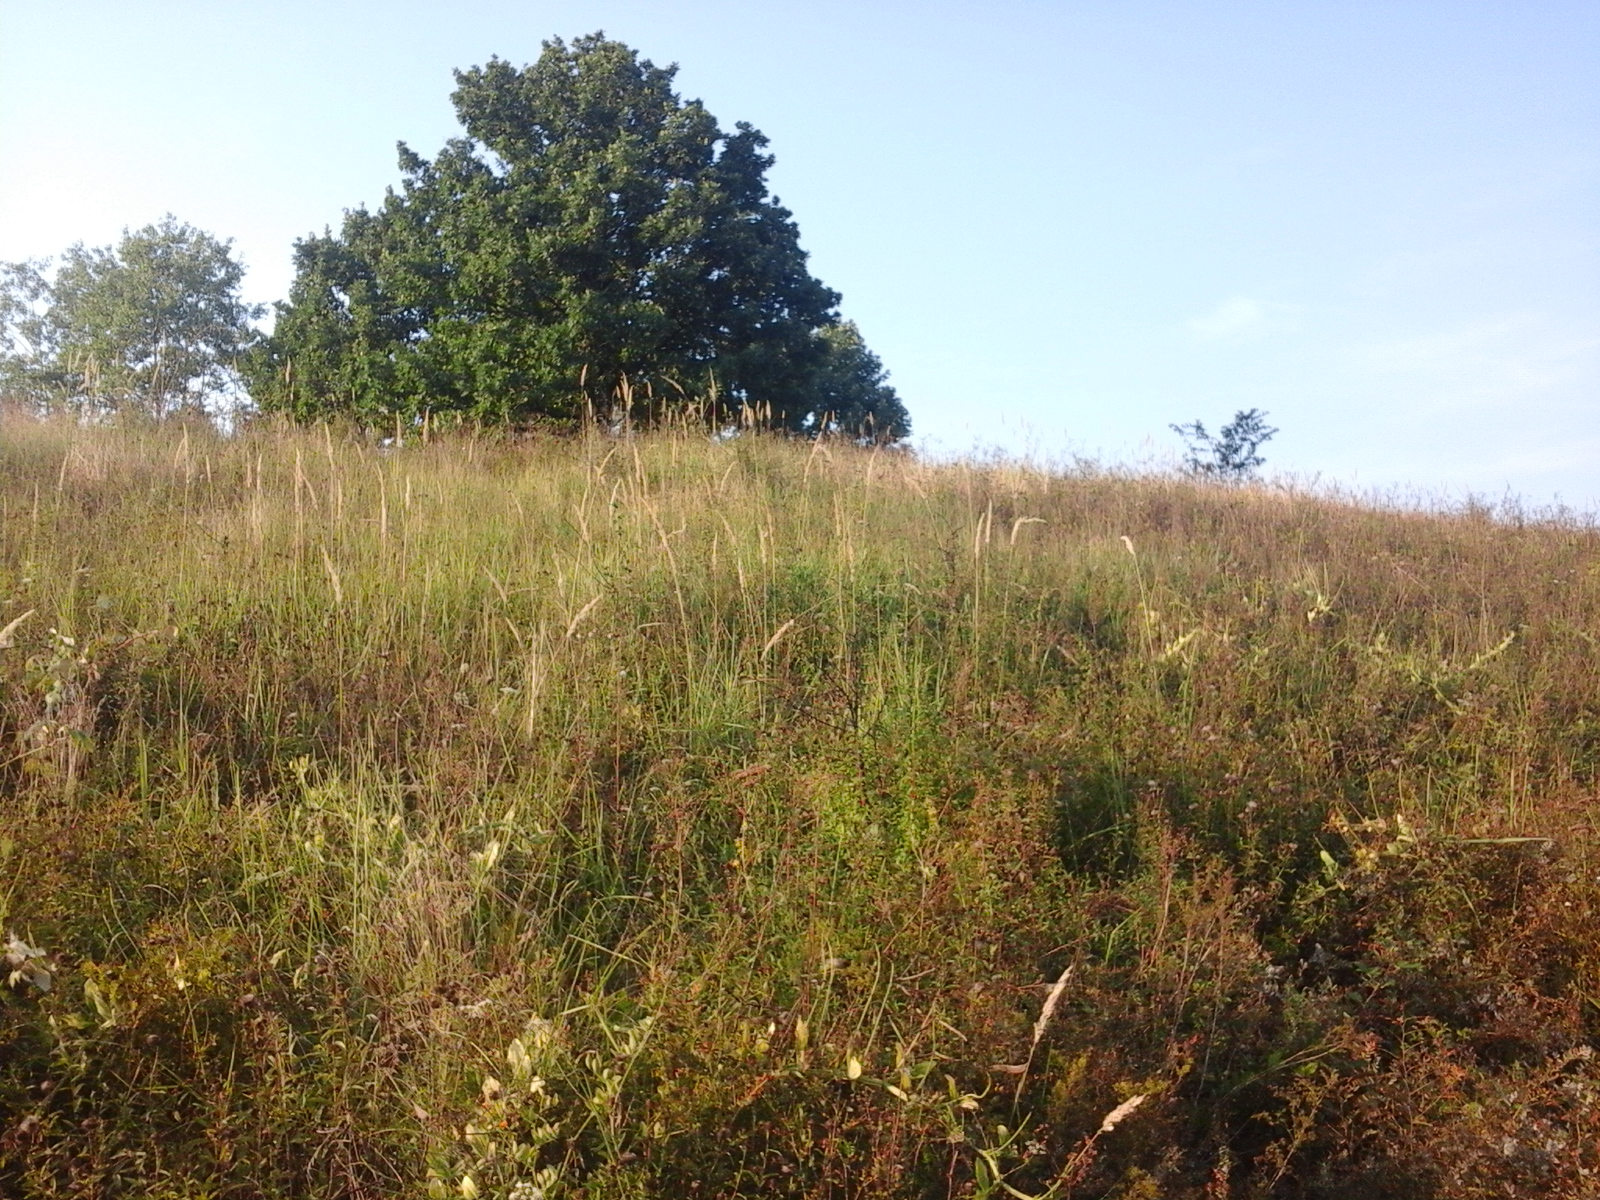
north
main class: Grassland
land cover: Spontaneously vegetated surfaces
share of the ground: > 75 %
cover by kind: herbaceous plants 100 %
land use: Fallow land
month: August
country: RO
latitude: 46.2389
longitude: 22.3022
